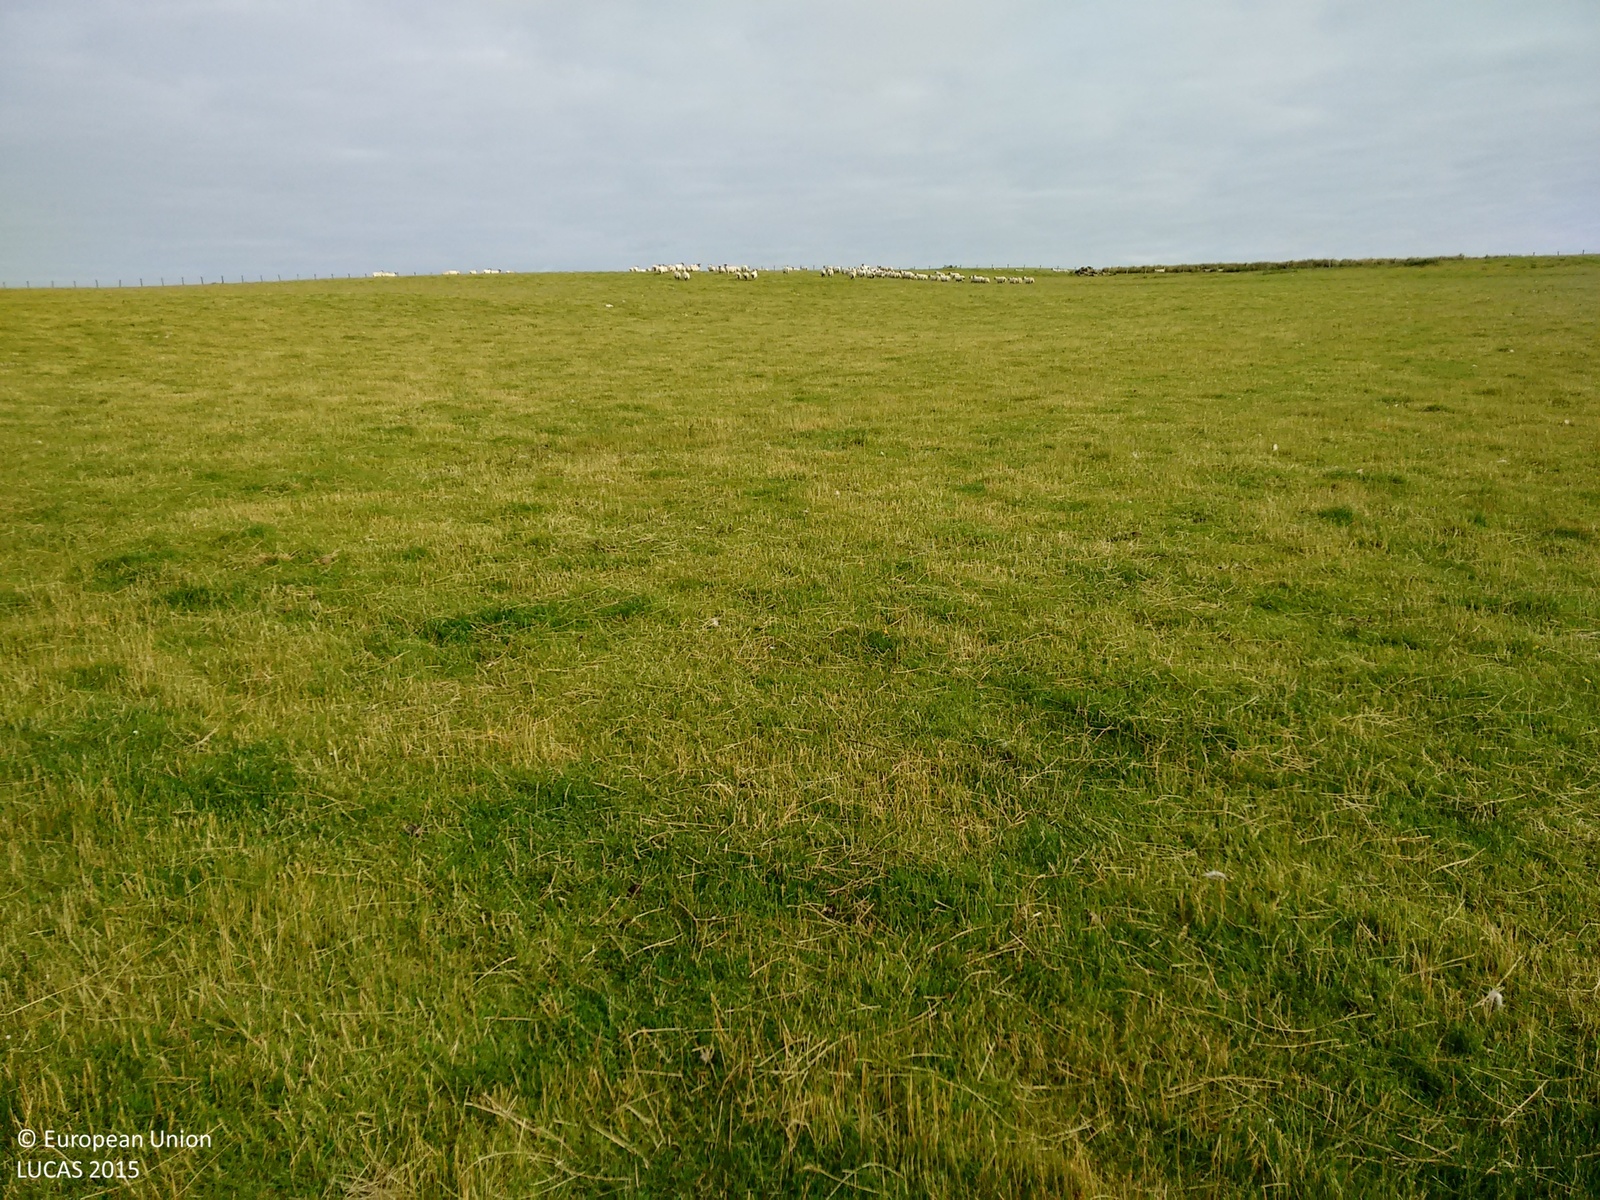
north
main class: Grassland
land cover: Grassland without tree/shrub cover
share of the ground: > 75 %
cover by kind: herbaceous plants 100 %
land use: Agriculture (excluding fallow land and kitchen gardens)
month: August
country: GB
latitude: 54.9237
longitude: -4.9193
